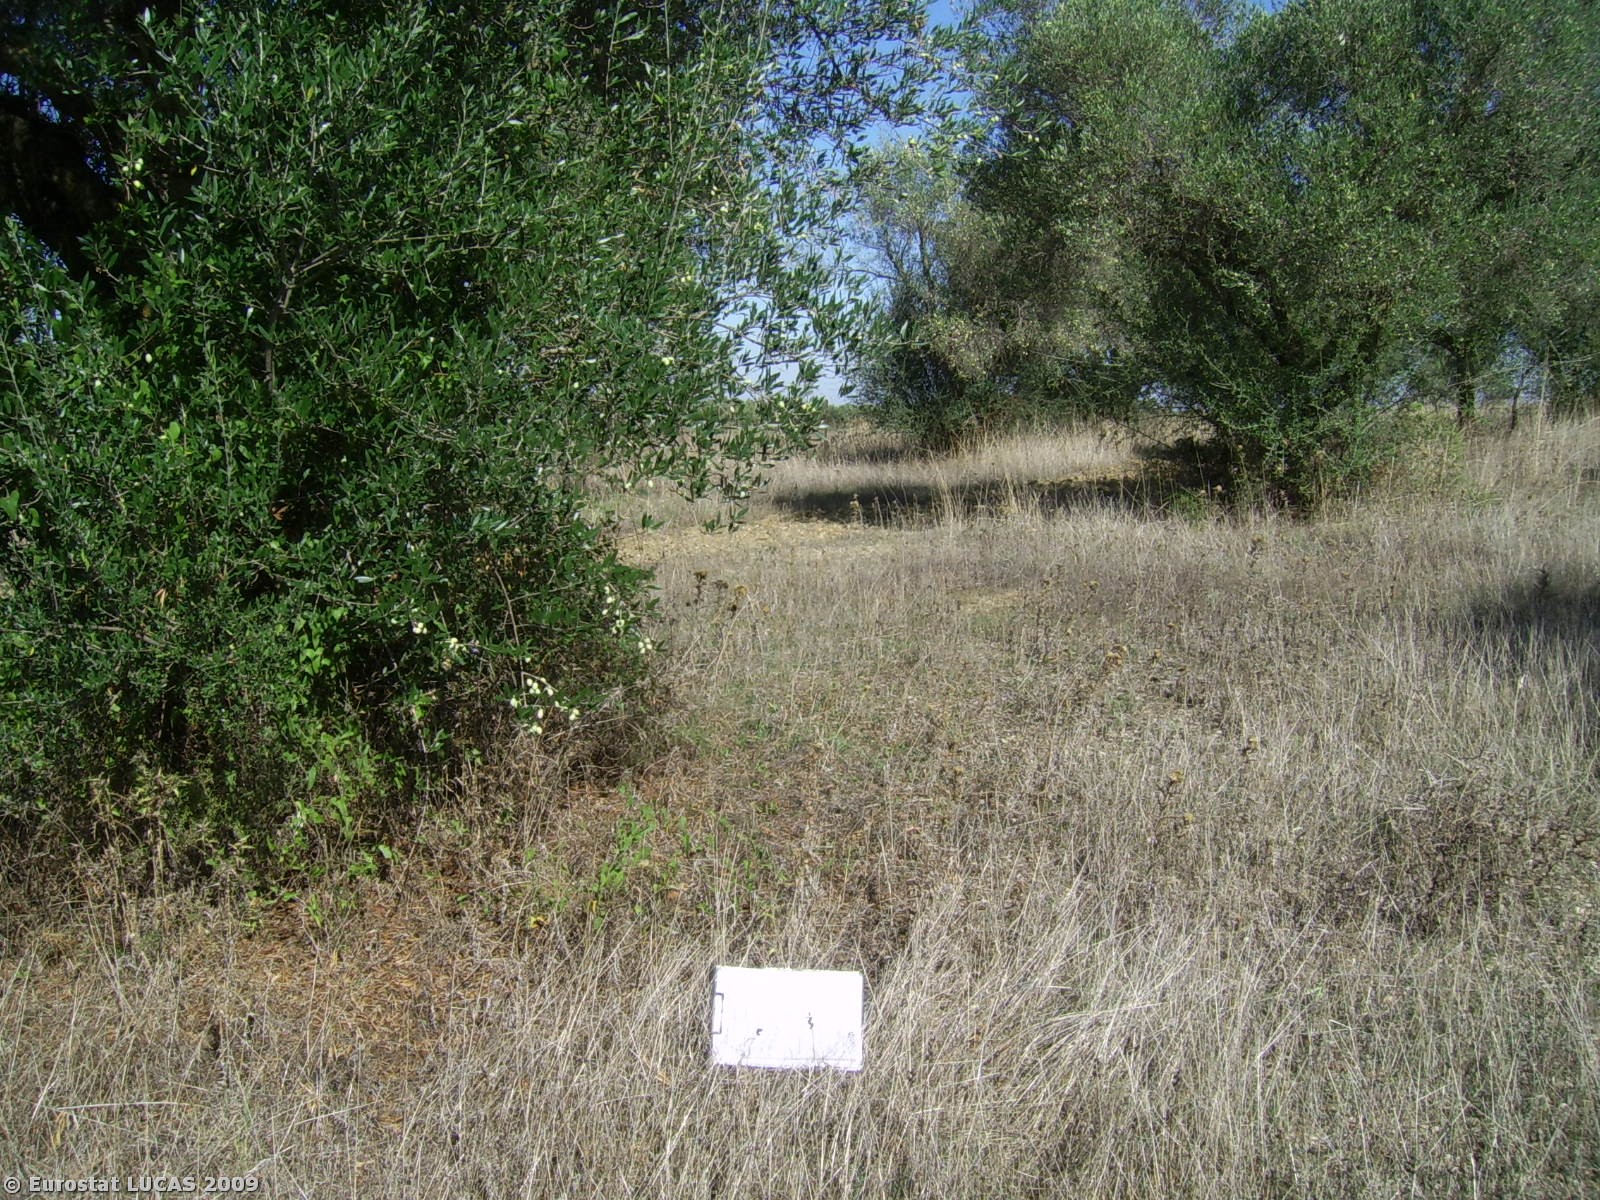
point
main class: Cropland
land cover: Olive groves
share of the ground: 50 - 75 %
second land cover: Grassland with sparse tree/shrub cover
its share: 50 - 75 %
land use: Agriculture (excluding fallow land and kitchen gardens)
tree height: > 5 m
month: October
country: GR
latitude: 37.9892
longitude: 21.4285
